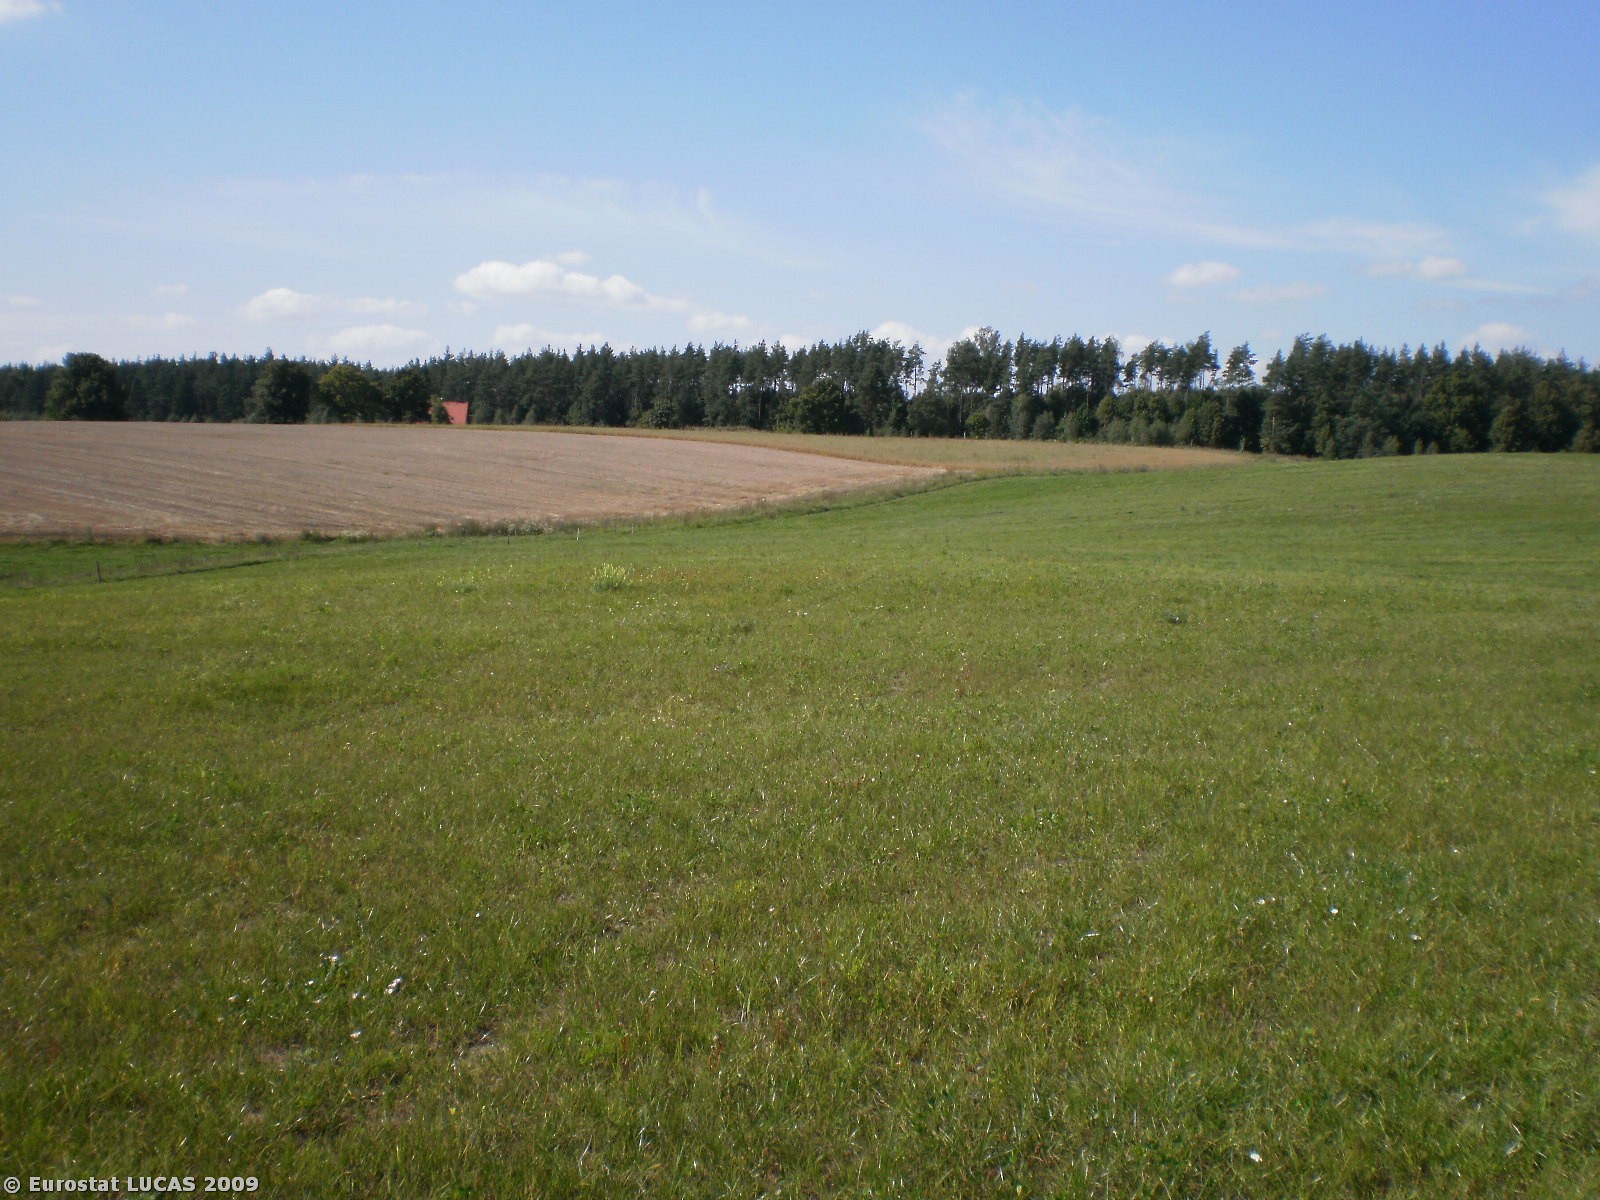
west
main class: Grassland
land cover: Grassland without tree/shrub cover
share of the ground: > 75 %
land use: Agriculture (excluding fallow land and kitchen gardens)
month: August
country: PL
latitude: 54.2059
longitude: 22.1553
